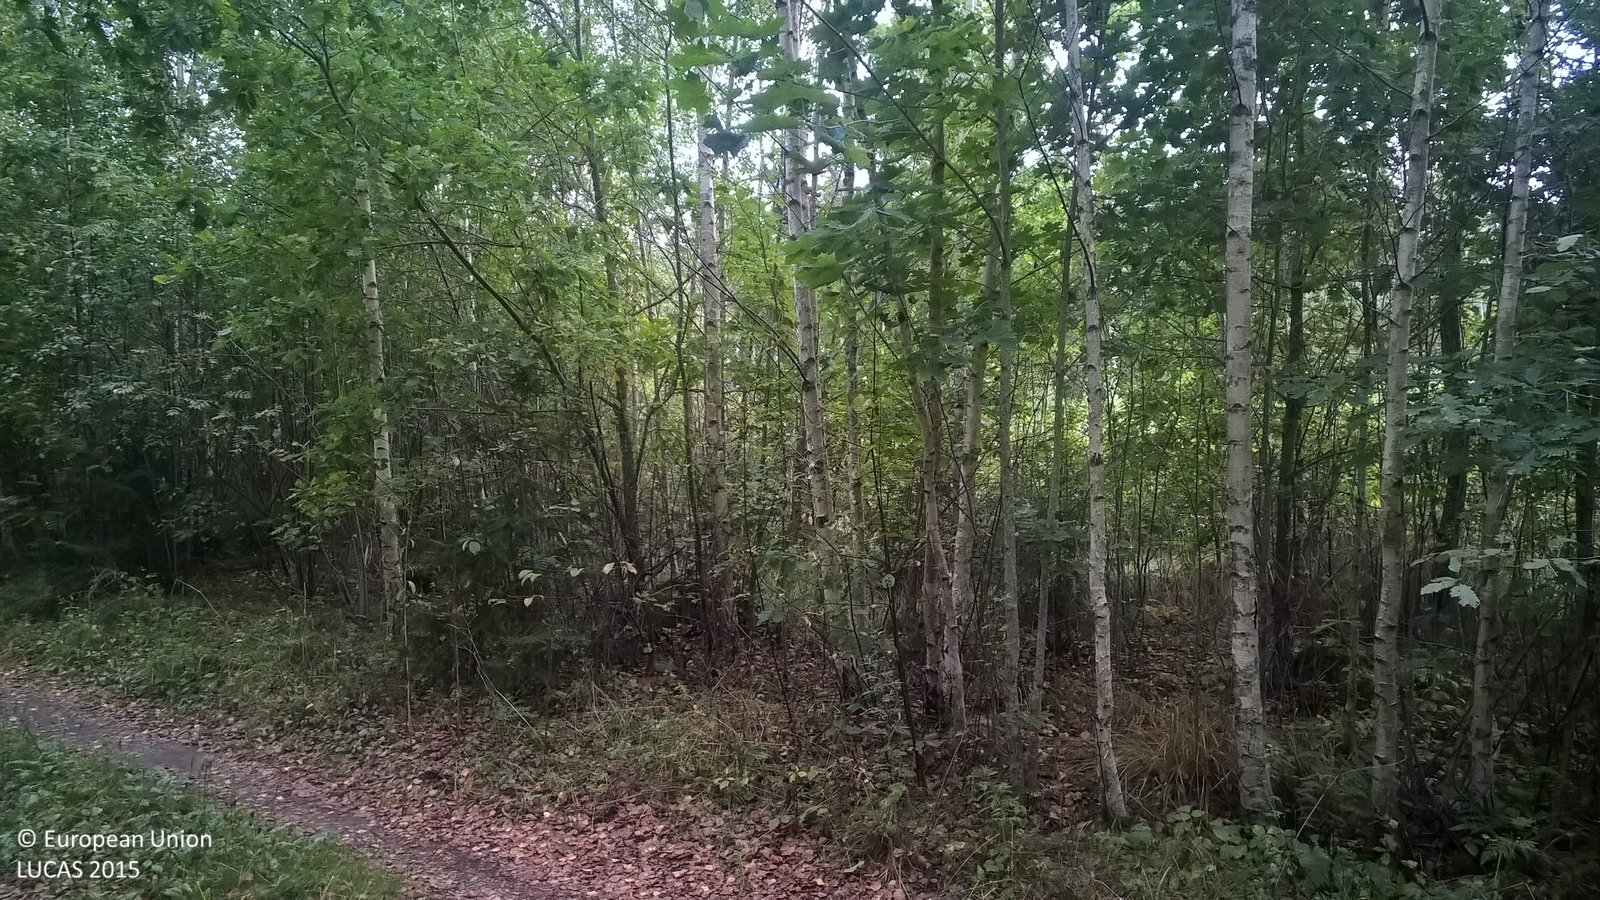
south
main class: Woodland
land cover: Broadleaved woodland
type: non-riverine alder, birch or aspen forest
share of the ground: > 75 %
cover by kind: broadleaved forest trees 85 %, herbaceous plants 10 %, shrubs 5 %
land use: Forestry
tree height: > 5 m
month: September
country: LV
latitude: 57.4841
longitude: 25.4425
